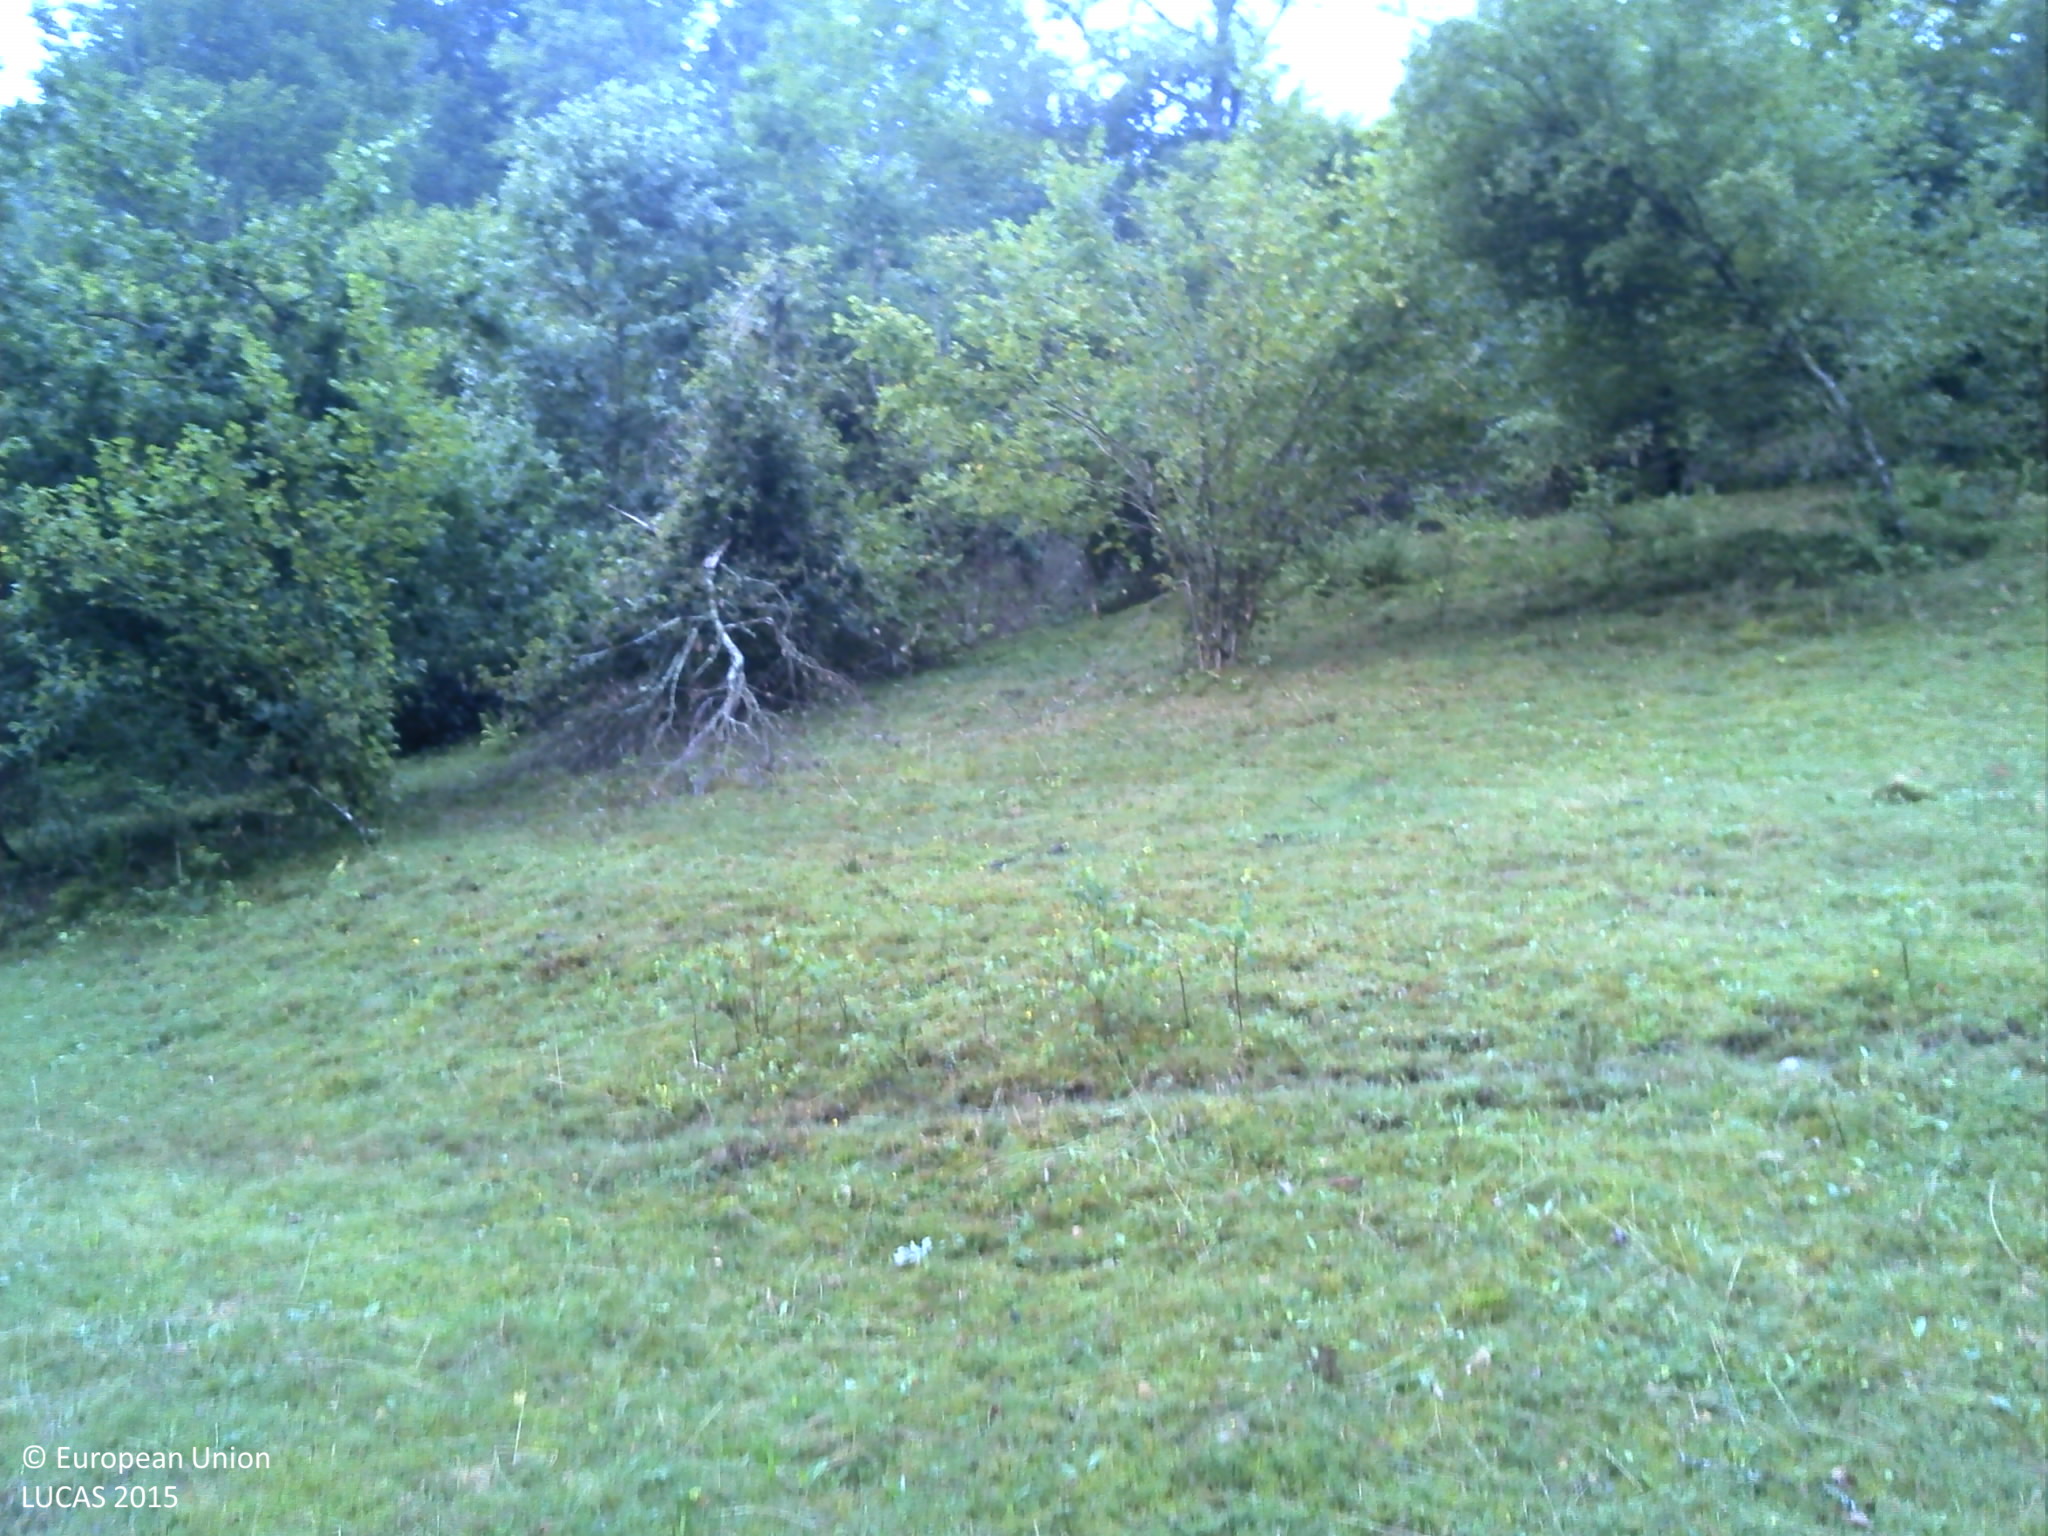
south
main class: Grassland
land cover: Grassland with sparse tree/shrub cover
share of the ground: > 75 %
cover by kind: herbaceous plants 95 %, broadleaved forest trees 5 %
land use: Agriculture (excluding fallow land and kitchen gardens)
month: August
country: FR
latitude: 47.8539
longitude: 6.8338
